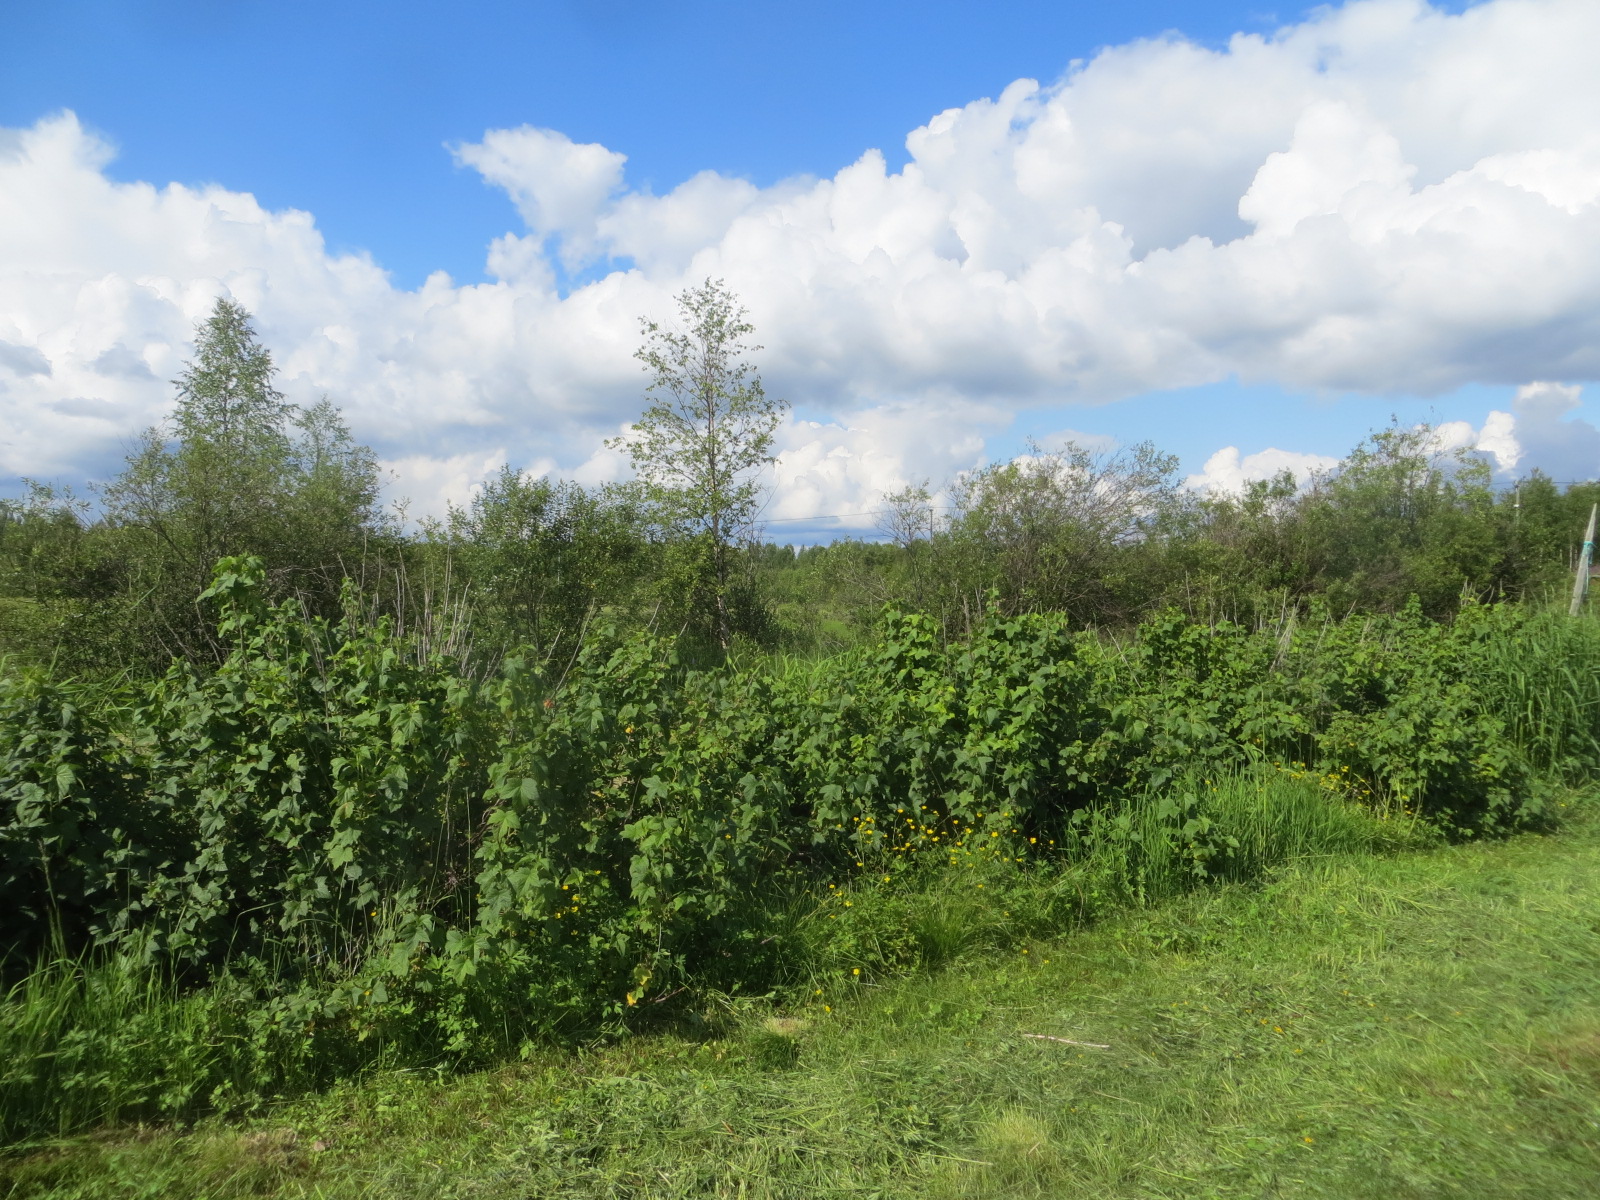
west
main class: Grassland
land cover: Grassland without tree/shrub cover
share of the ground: > 75 %
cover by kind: herbaceous plants 100 %
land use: Agriculture (excluding fallow land and kitchen gardens)
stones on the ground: < 10 %
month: July
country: FI
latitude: 66.4693
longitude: 25.6223
